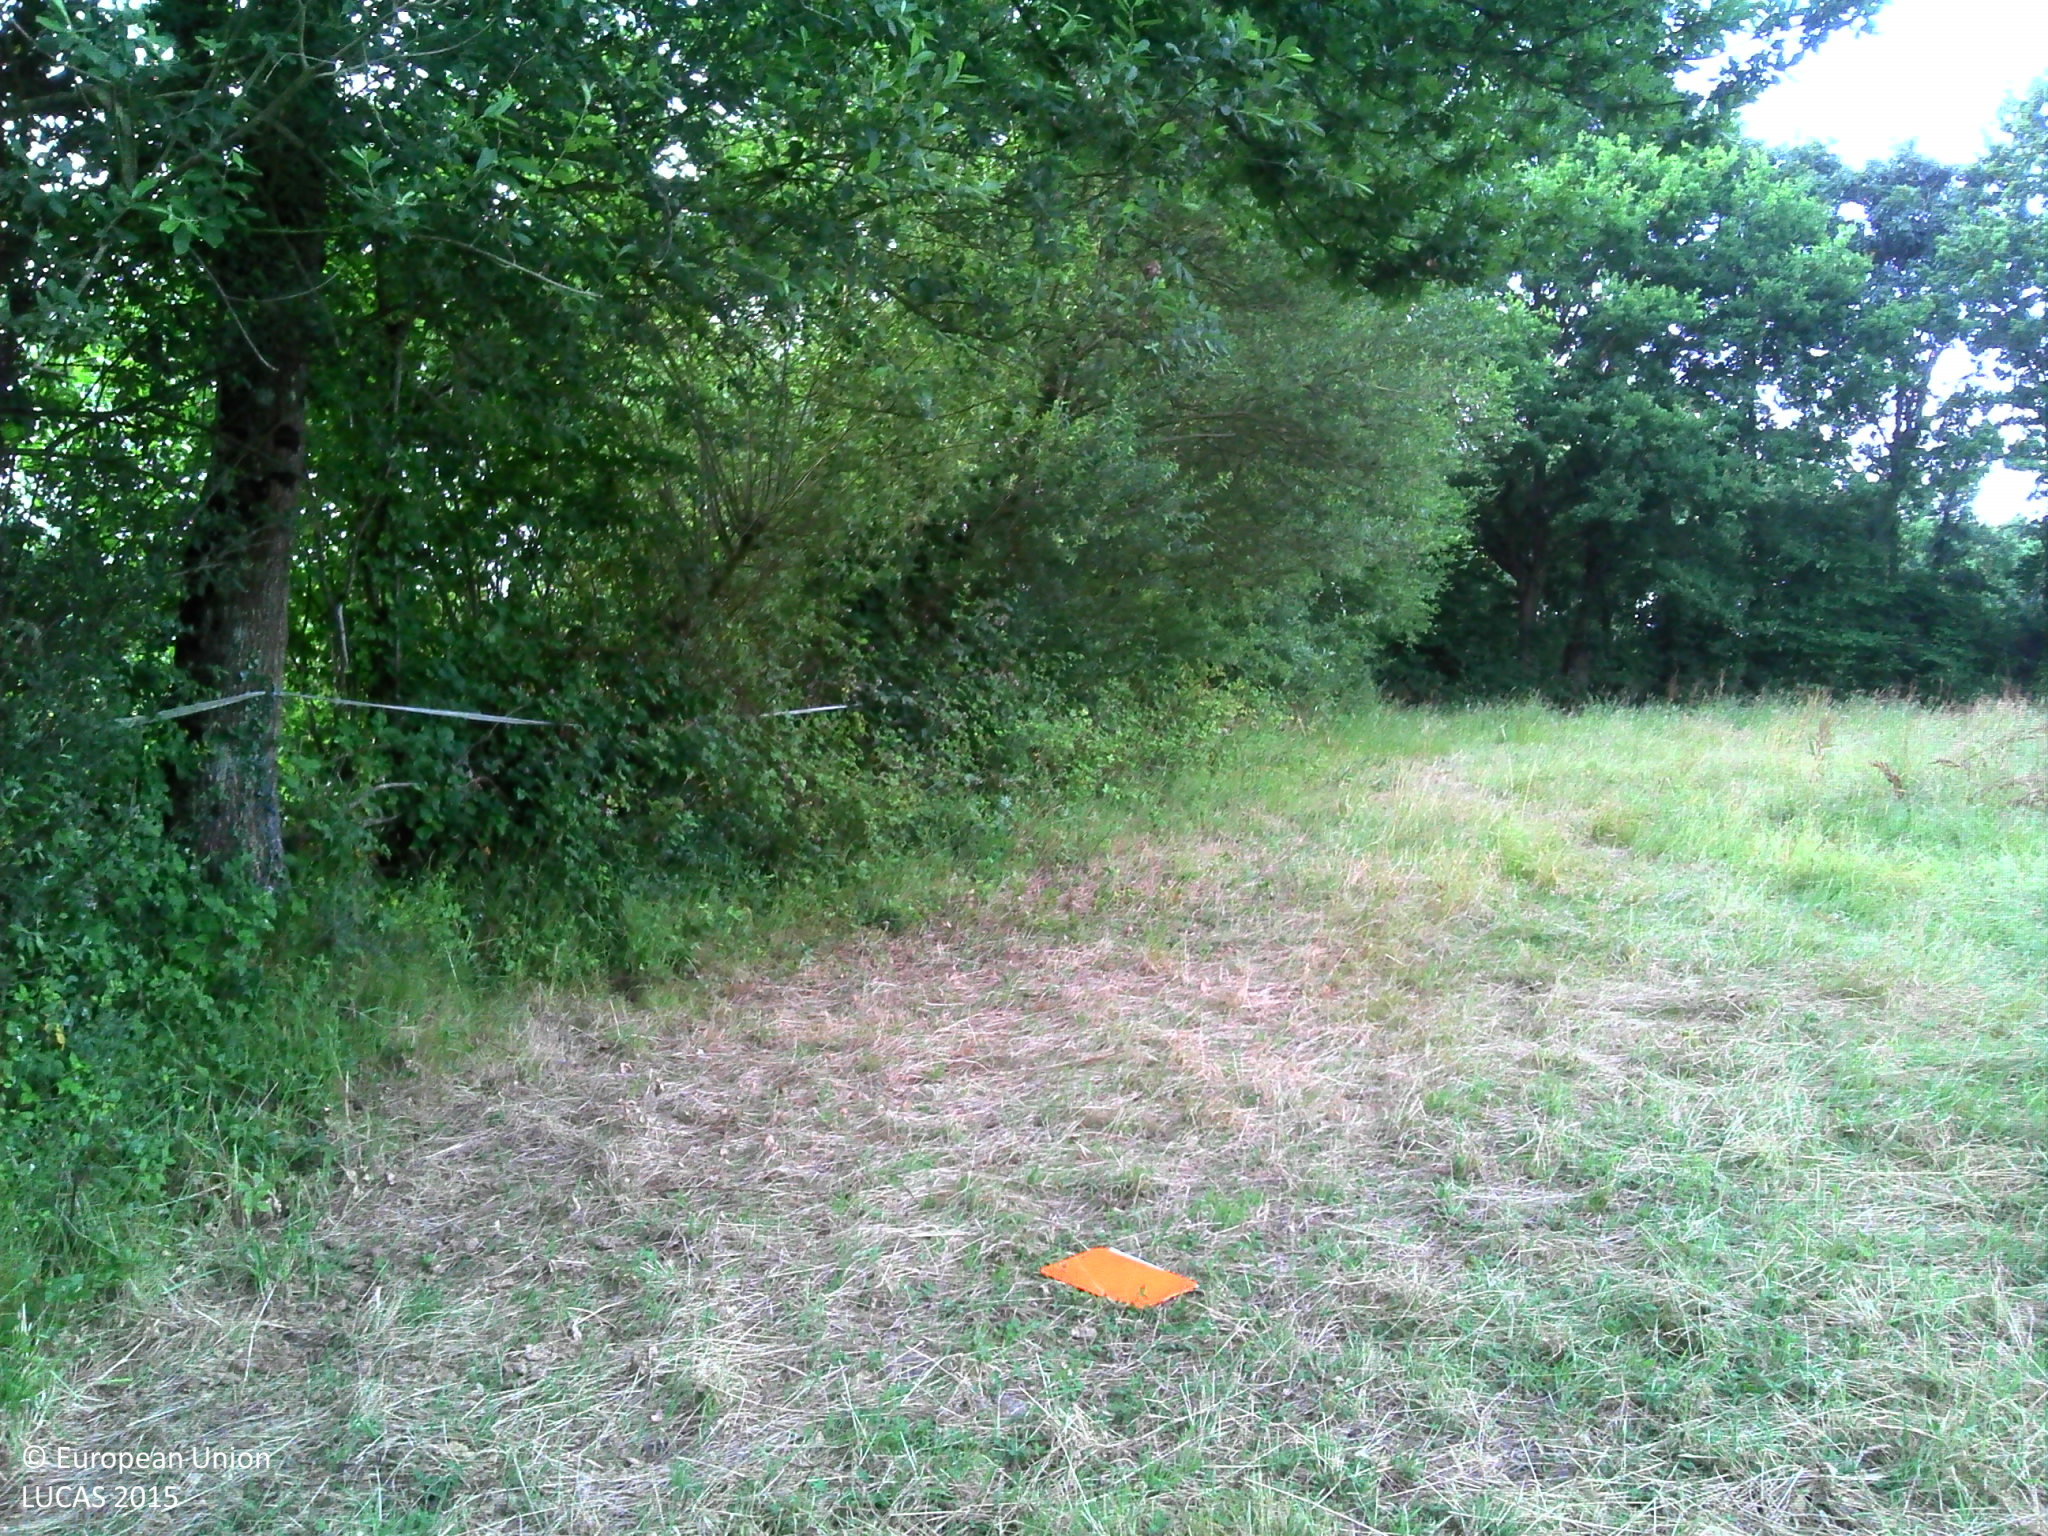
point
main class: Woodland
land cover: Broadleaved woodland
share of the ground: > 75 %
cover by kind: broadleaved forest trees 50 %, shrubs 40 %, herbaceous plants 10 %
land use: Agriculture (excluding fallow land and kitchen gardens)
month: June
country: FR
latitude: 47.3216
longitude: -1.5666
